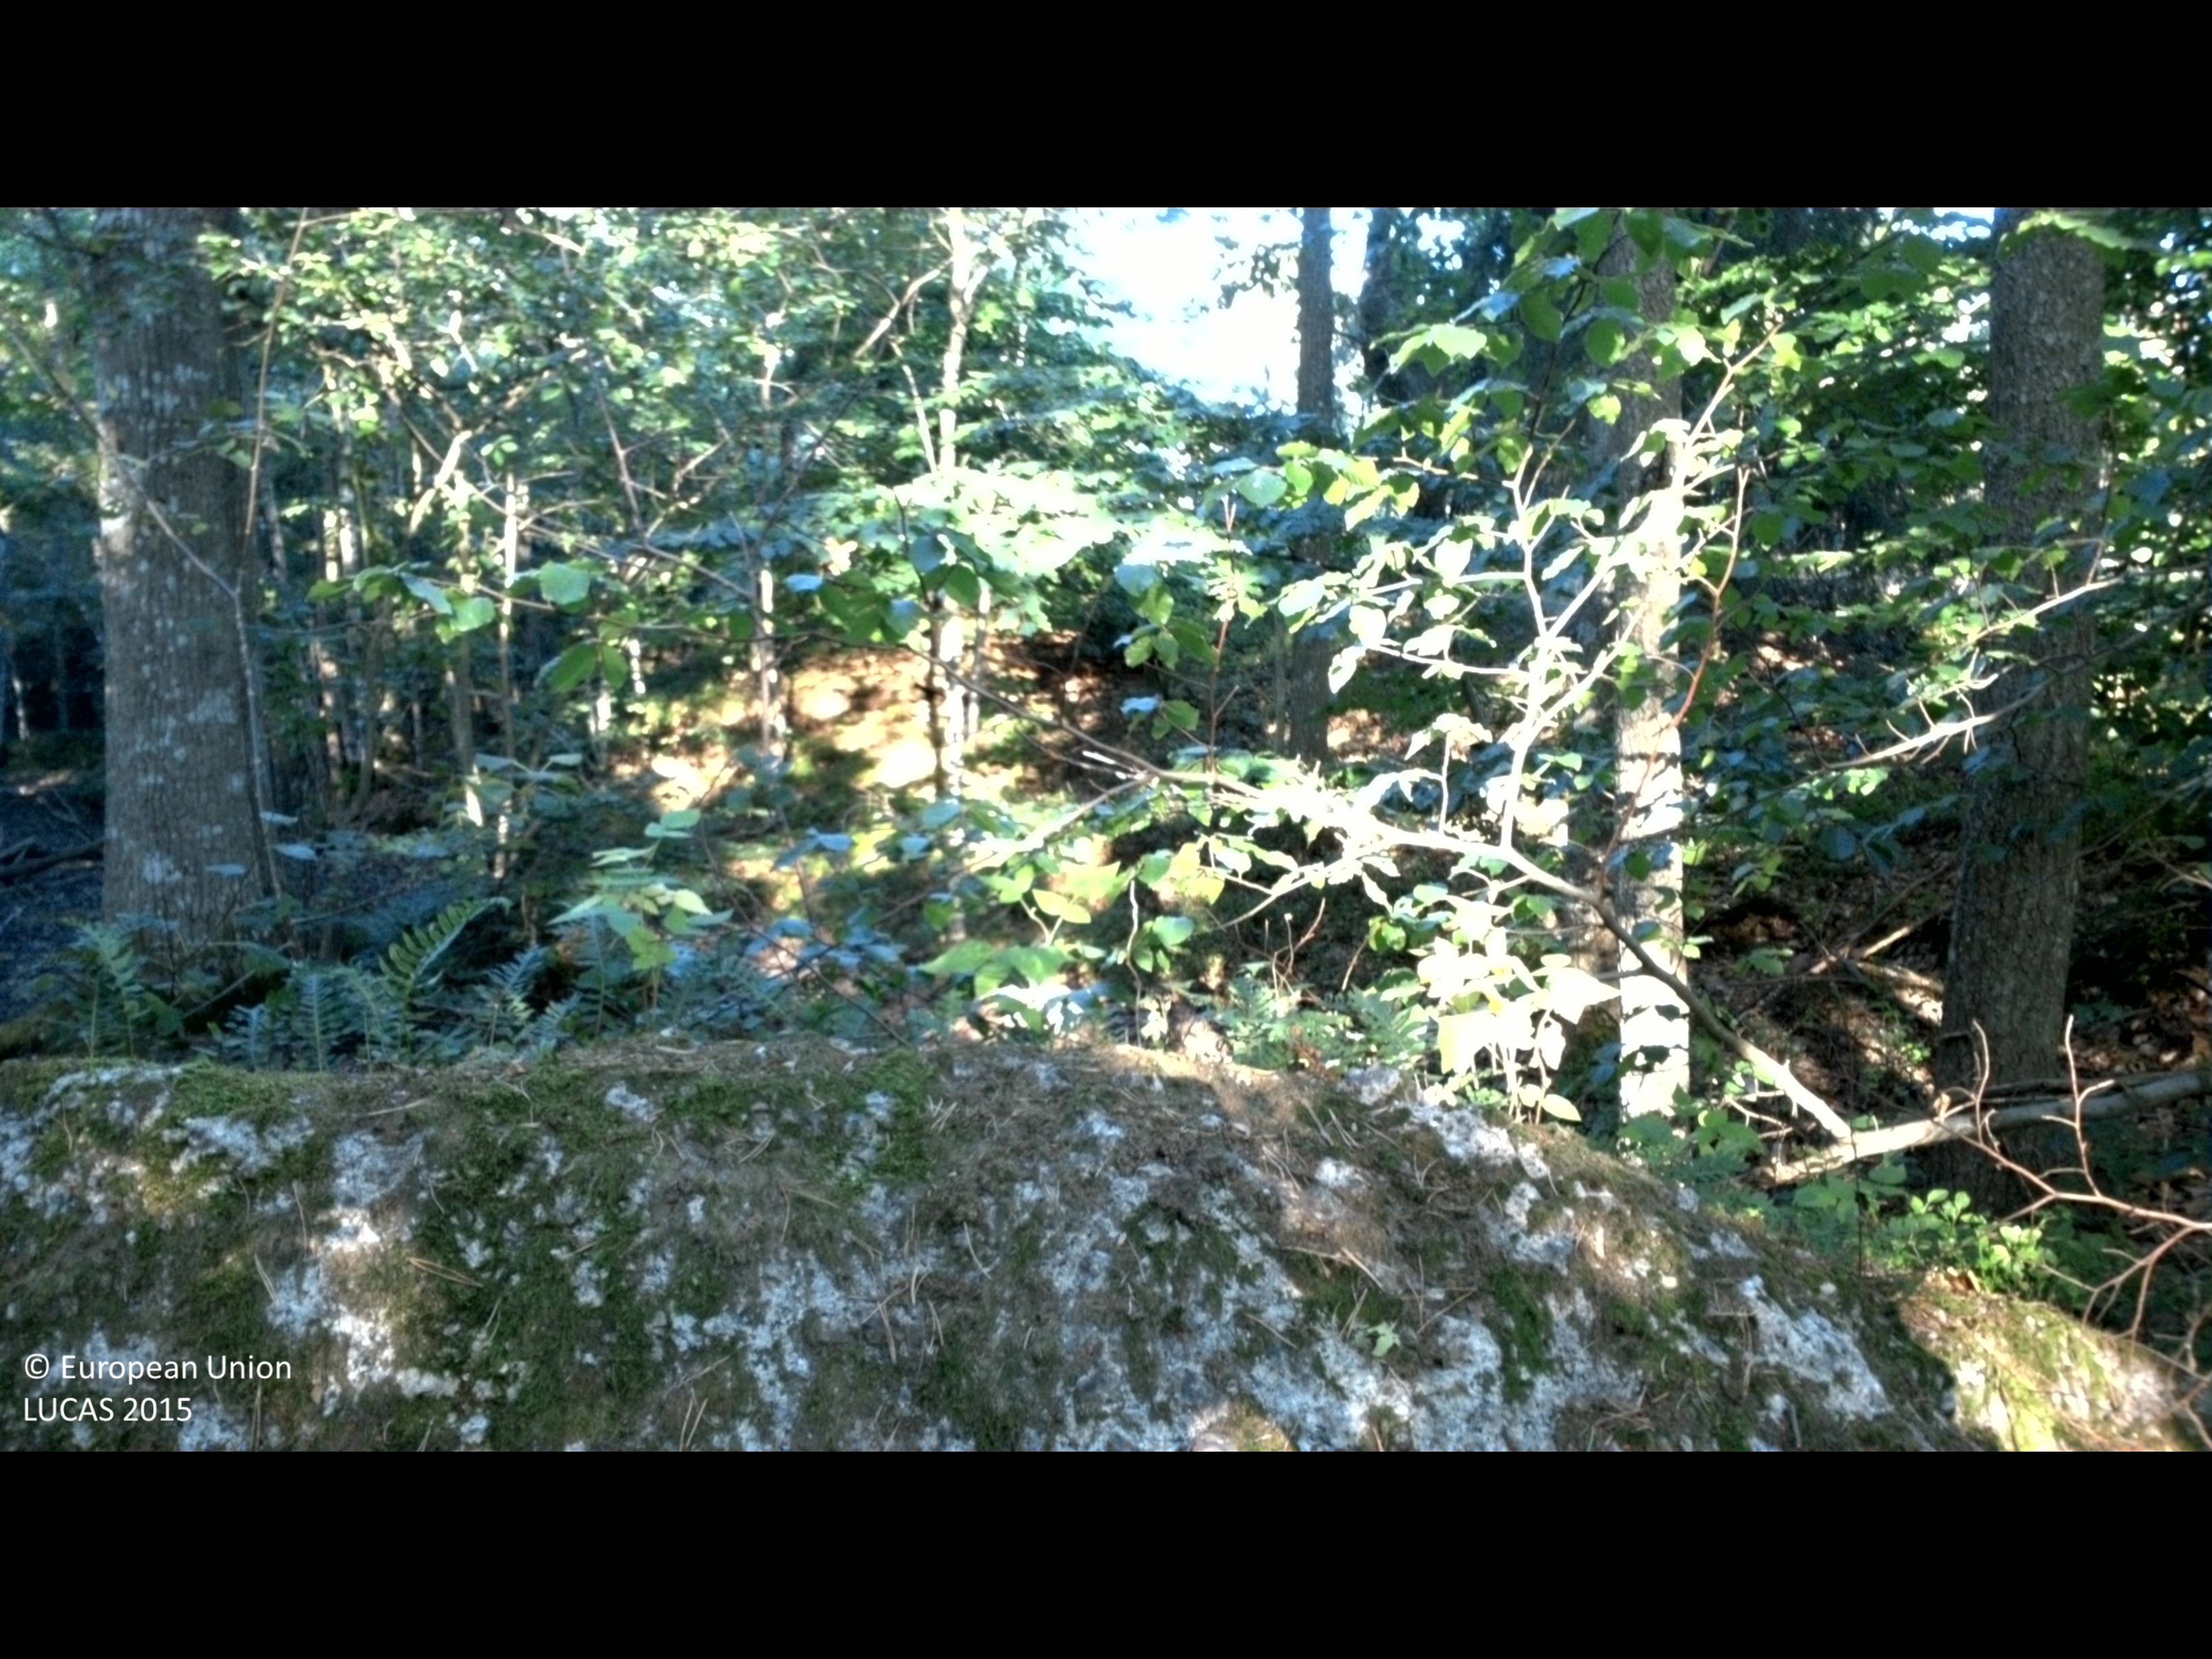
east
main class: Woodland
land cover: Broadleaved woodland
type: mesophytic deciduous forest
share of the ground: 50 - 75 %
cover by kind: broadleaved forest trees 60 %, herbaceous plants 10 %, coniferous forest trees 5 %, lichens and mosses 5 %
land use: Forestry
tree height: > 5 m
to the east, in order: Broadleaved woodland; Spruce dominated coniferous woodland; Broadleaved woodland
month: August
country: SE
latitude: 56.1865
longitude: 15.3002
